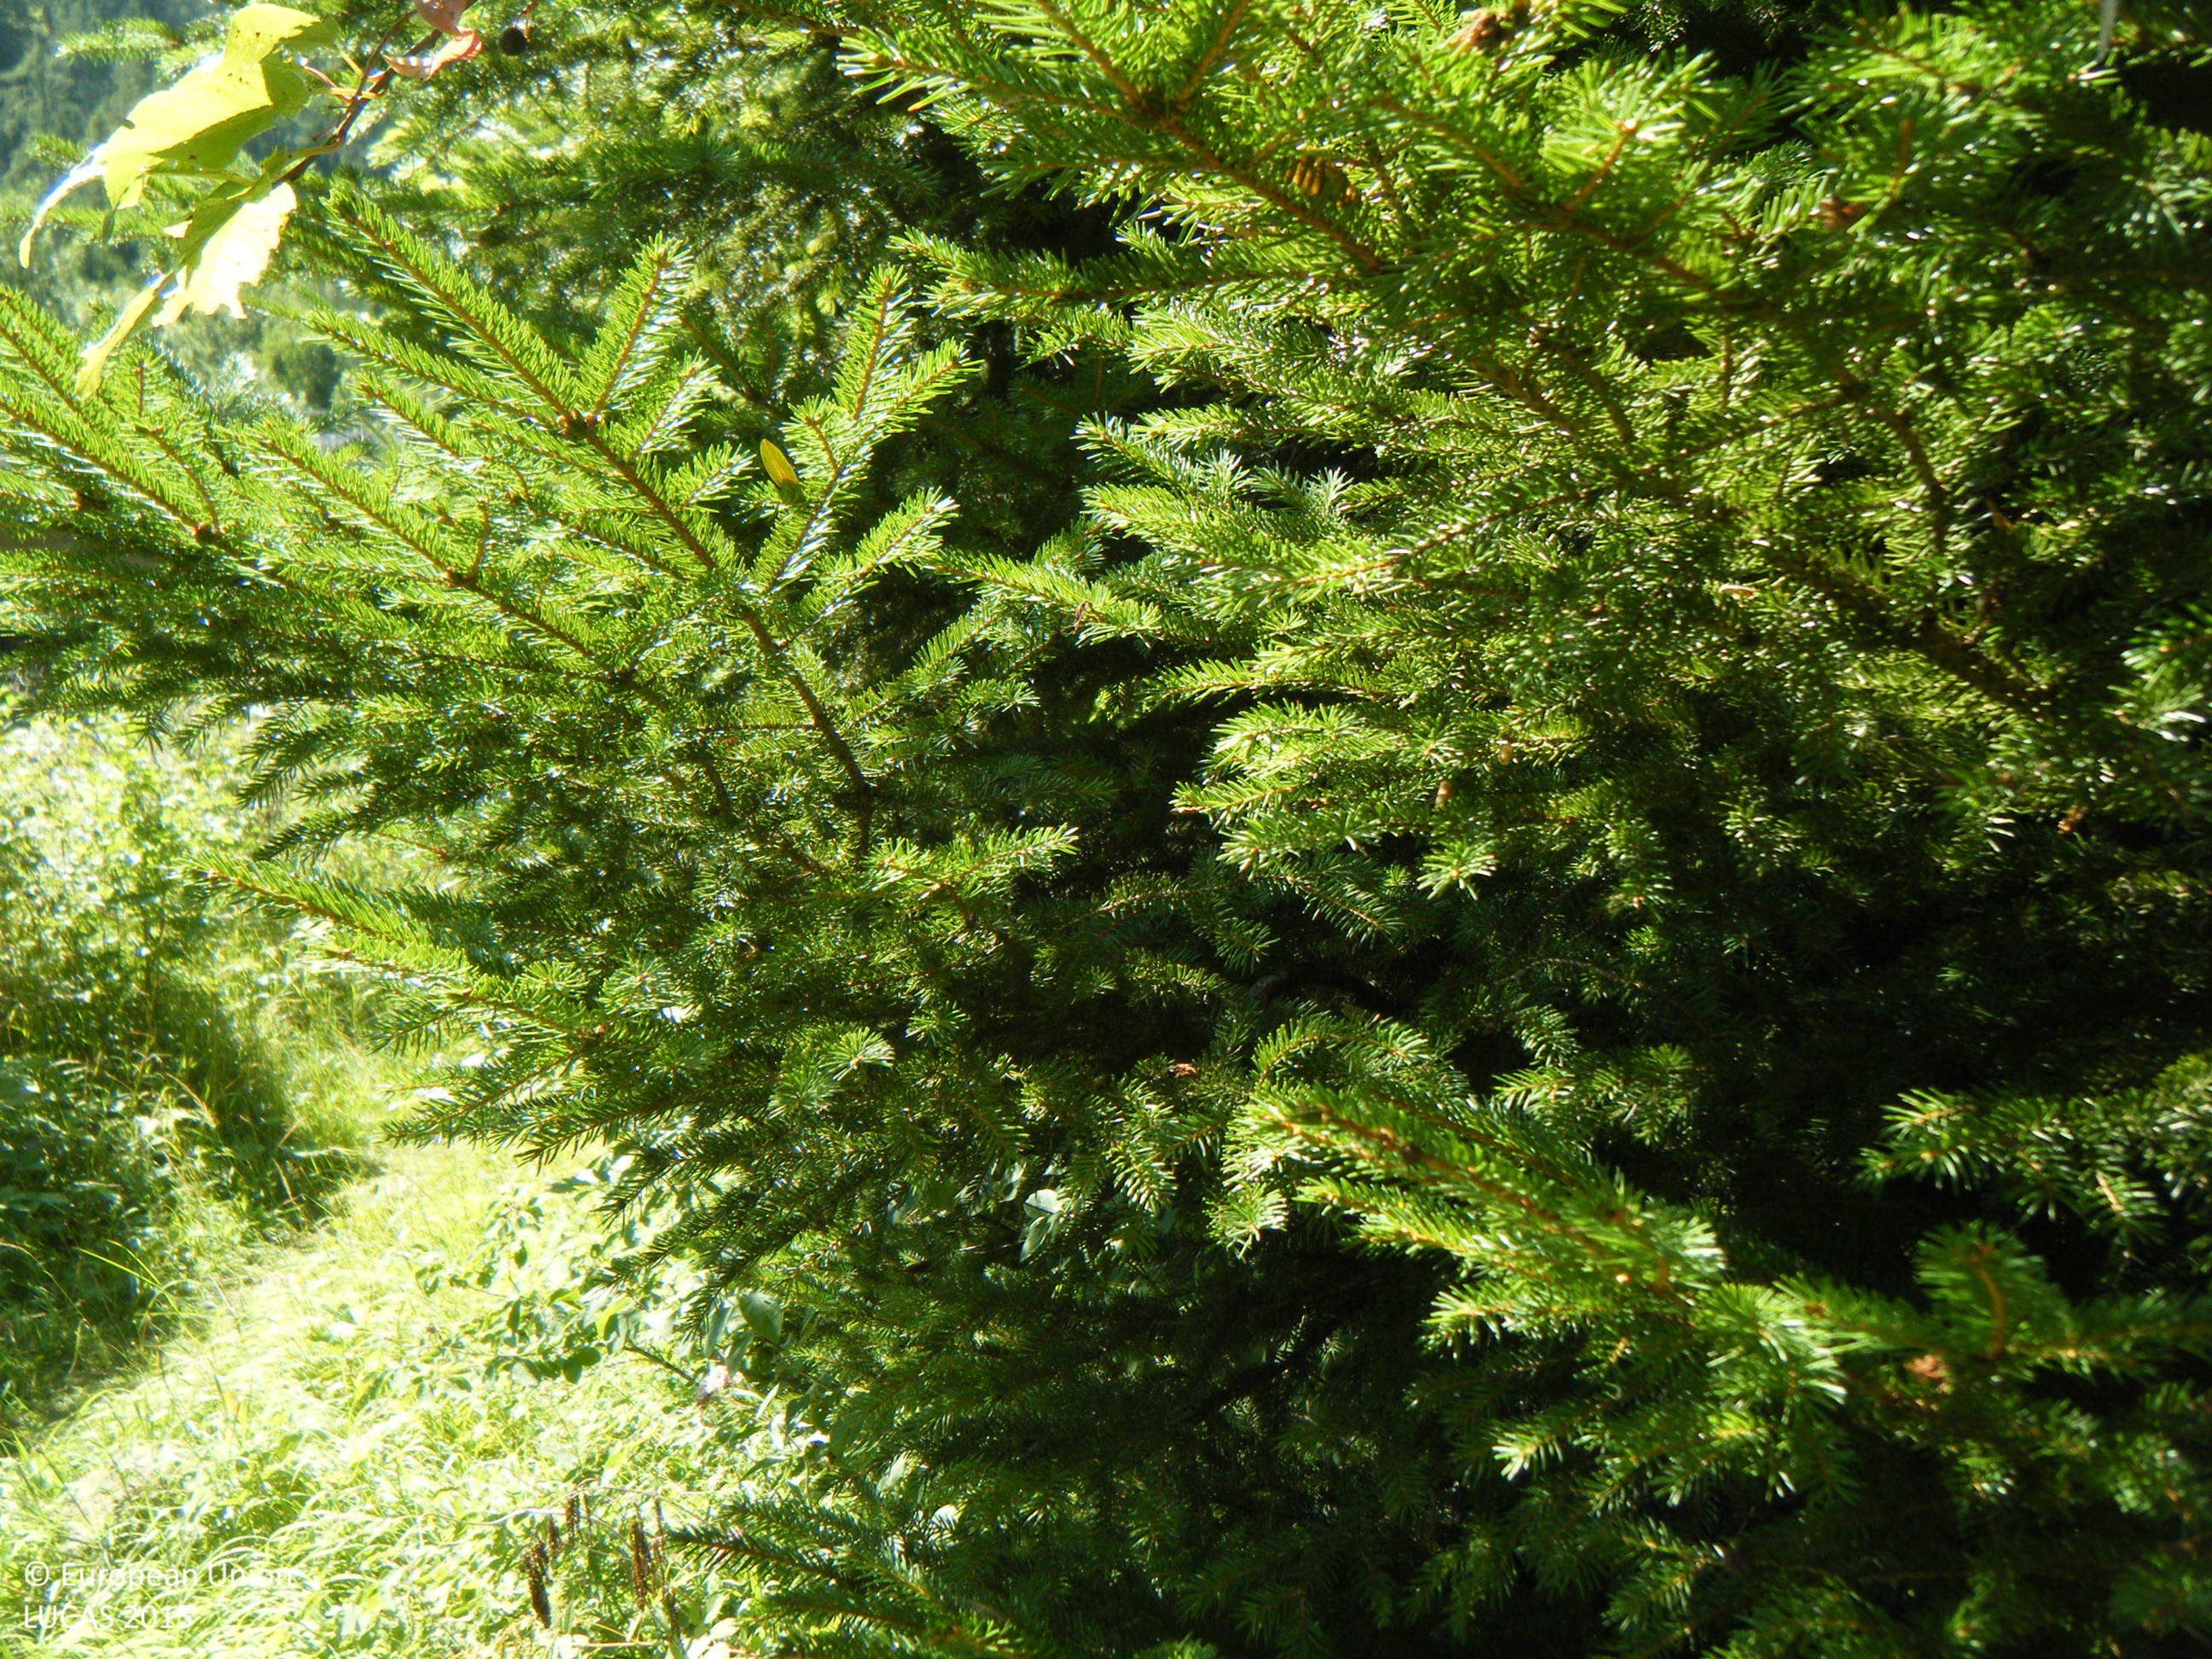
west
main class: Woodland
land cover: Broadleaved woodland
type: floodplain forest
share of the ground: > 75 %
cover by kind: broadleaved forest trees 70 %, coniferous forest trees 20 %, shrubs 5 %, herbaceous plants 5 %
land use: Forestry
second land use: Amenities, museums, leisure
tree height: > 5 m
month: August
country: AT
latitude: 47.5365
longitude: 14.0505
